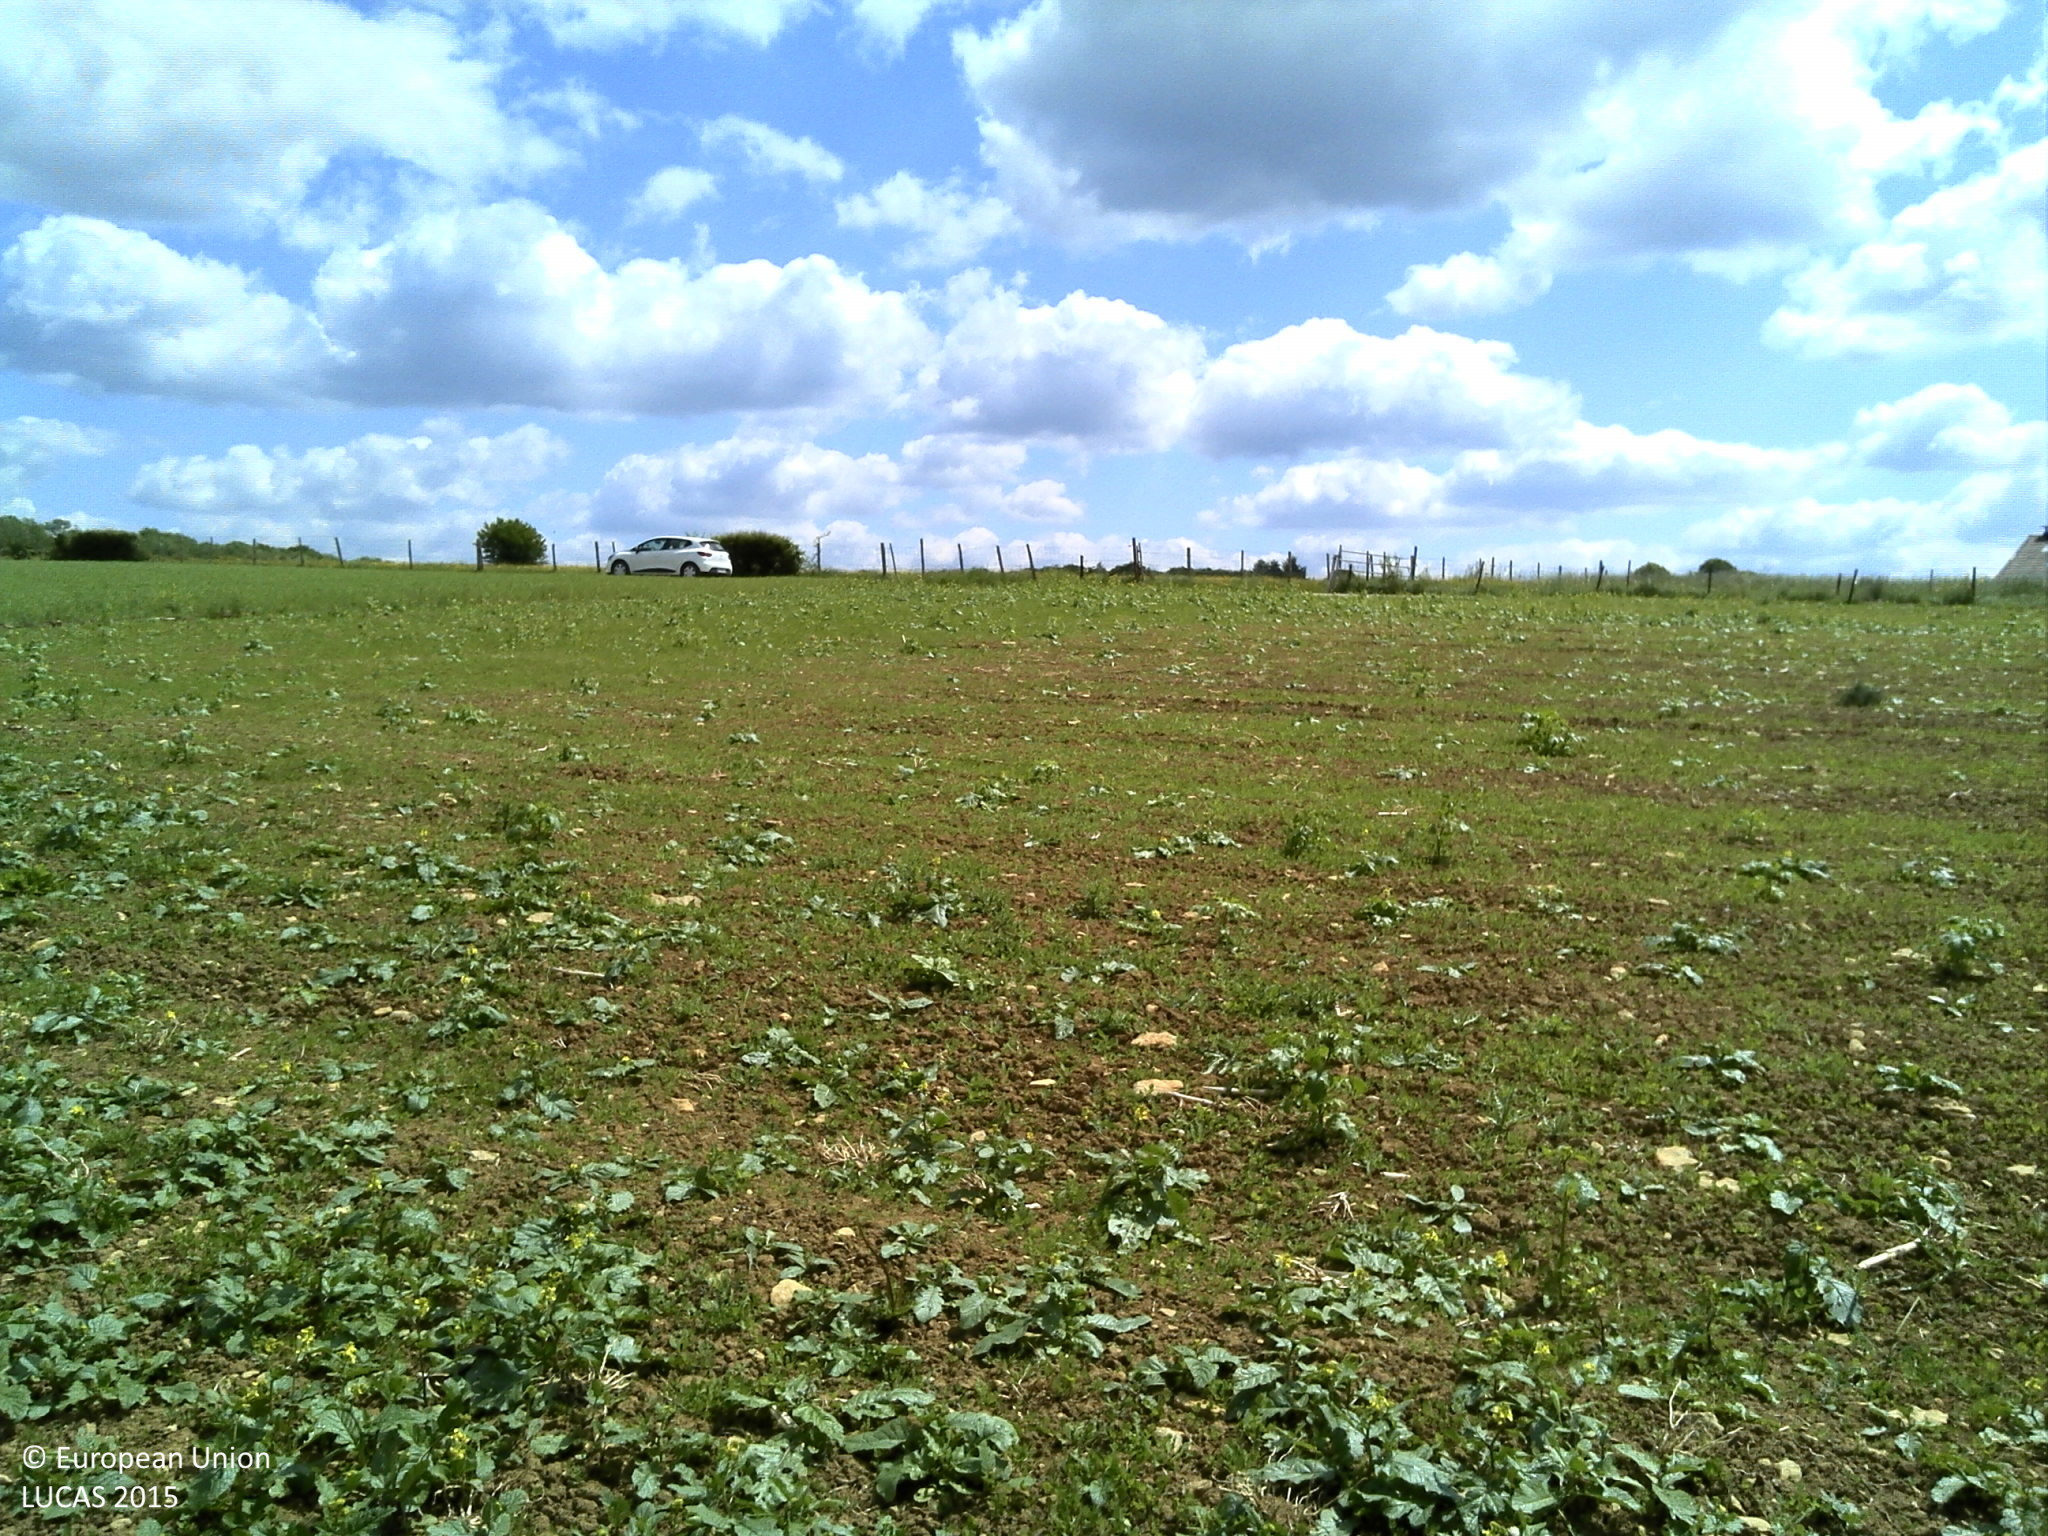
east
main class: Cropland
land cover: Temporary grasslands
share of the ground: > 75 %
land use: Agriculture (excluding fallow land and kitchen gardens)
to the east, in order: Clovers; Grass margins; Other cereals; Paved roads, cycling and walking lanes; Grass margins; Ditches and canals; Fences; Grassland without tree/shrub cover; Abandoned hedges; Grassland without tree/shrub cover; Fences; Grassland without tree/shrub cover
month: May
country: LU
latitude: 49.7186
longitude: 6.0185
